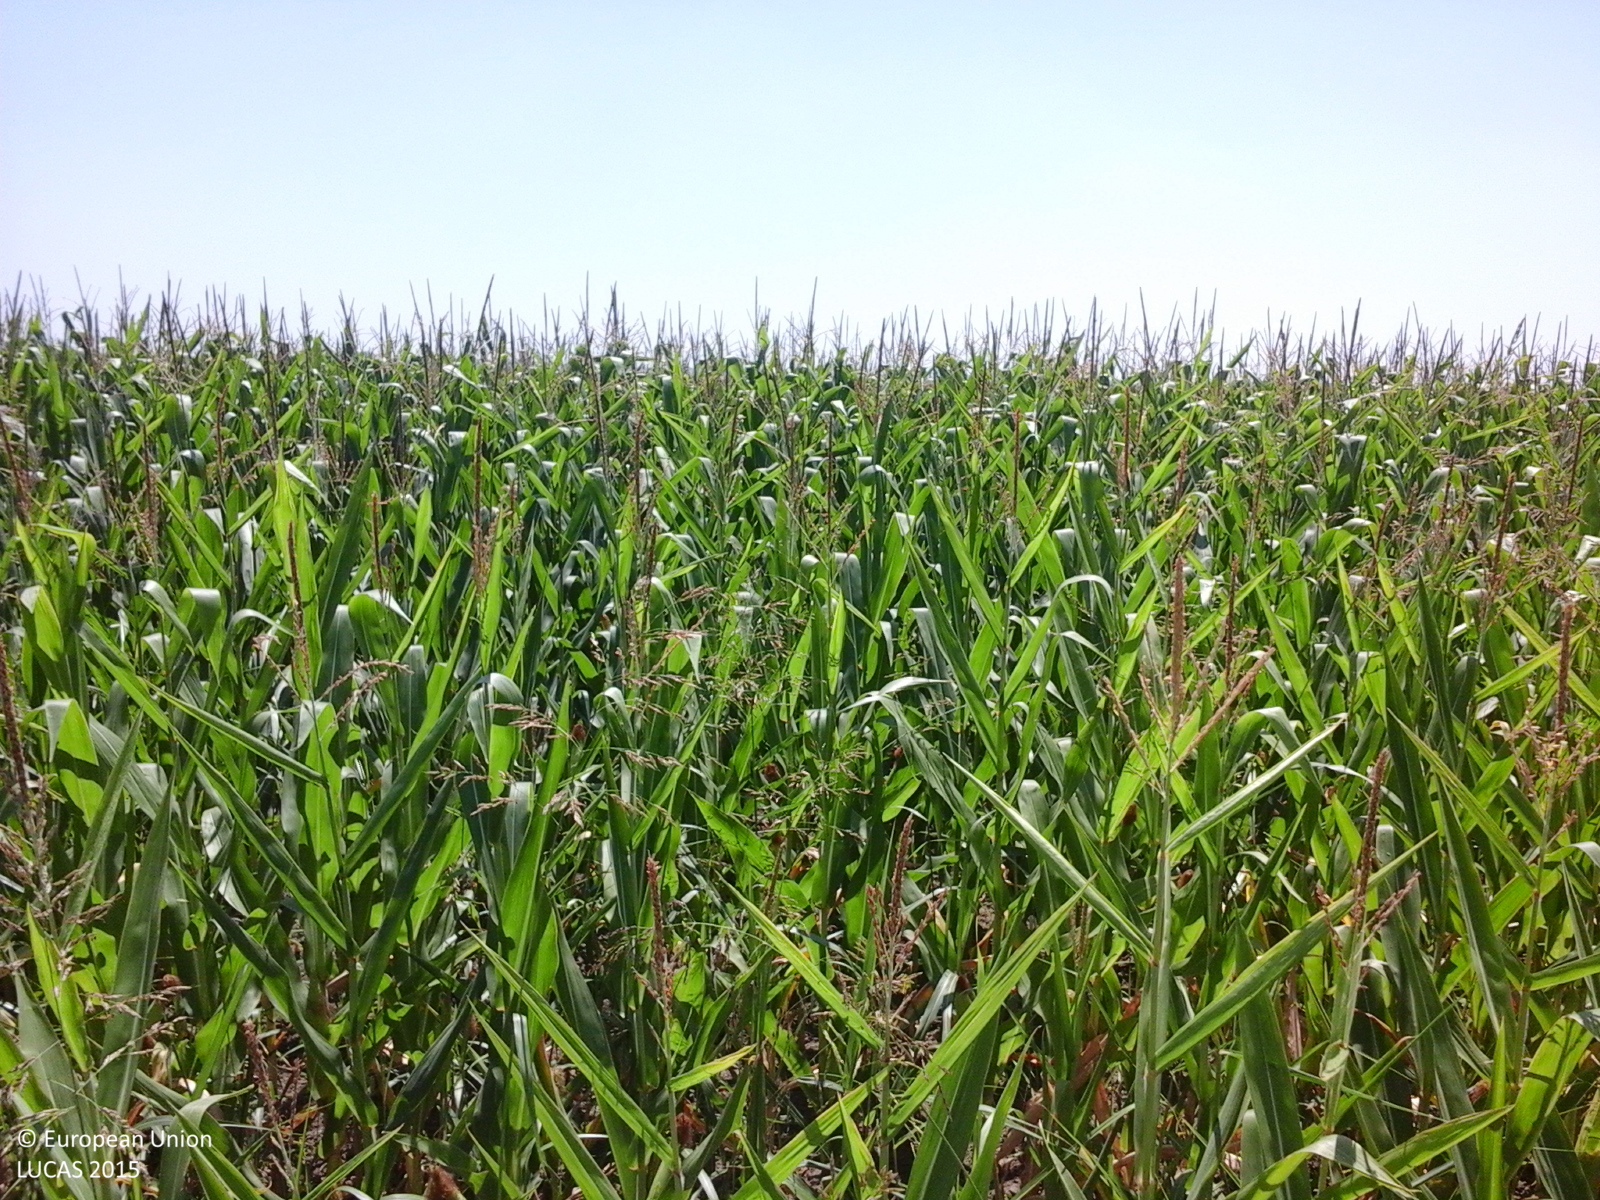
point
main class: Cropland
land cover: Maize
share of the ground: > 75 %
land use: Agriculture (excluding fallow land and kitchen gardens)
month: July
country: RO
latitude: 44.1903
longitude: 26.9770
